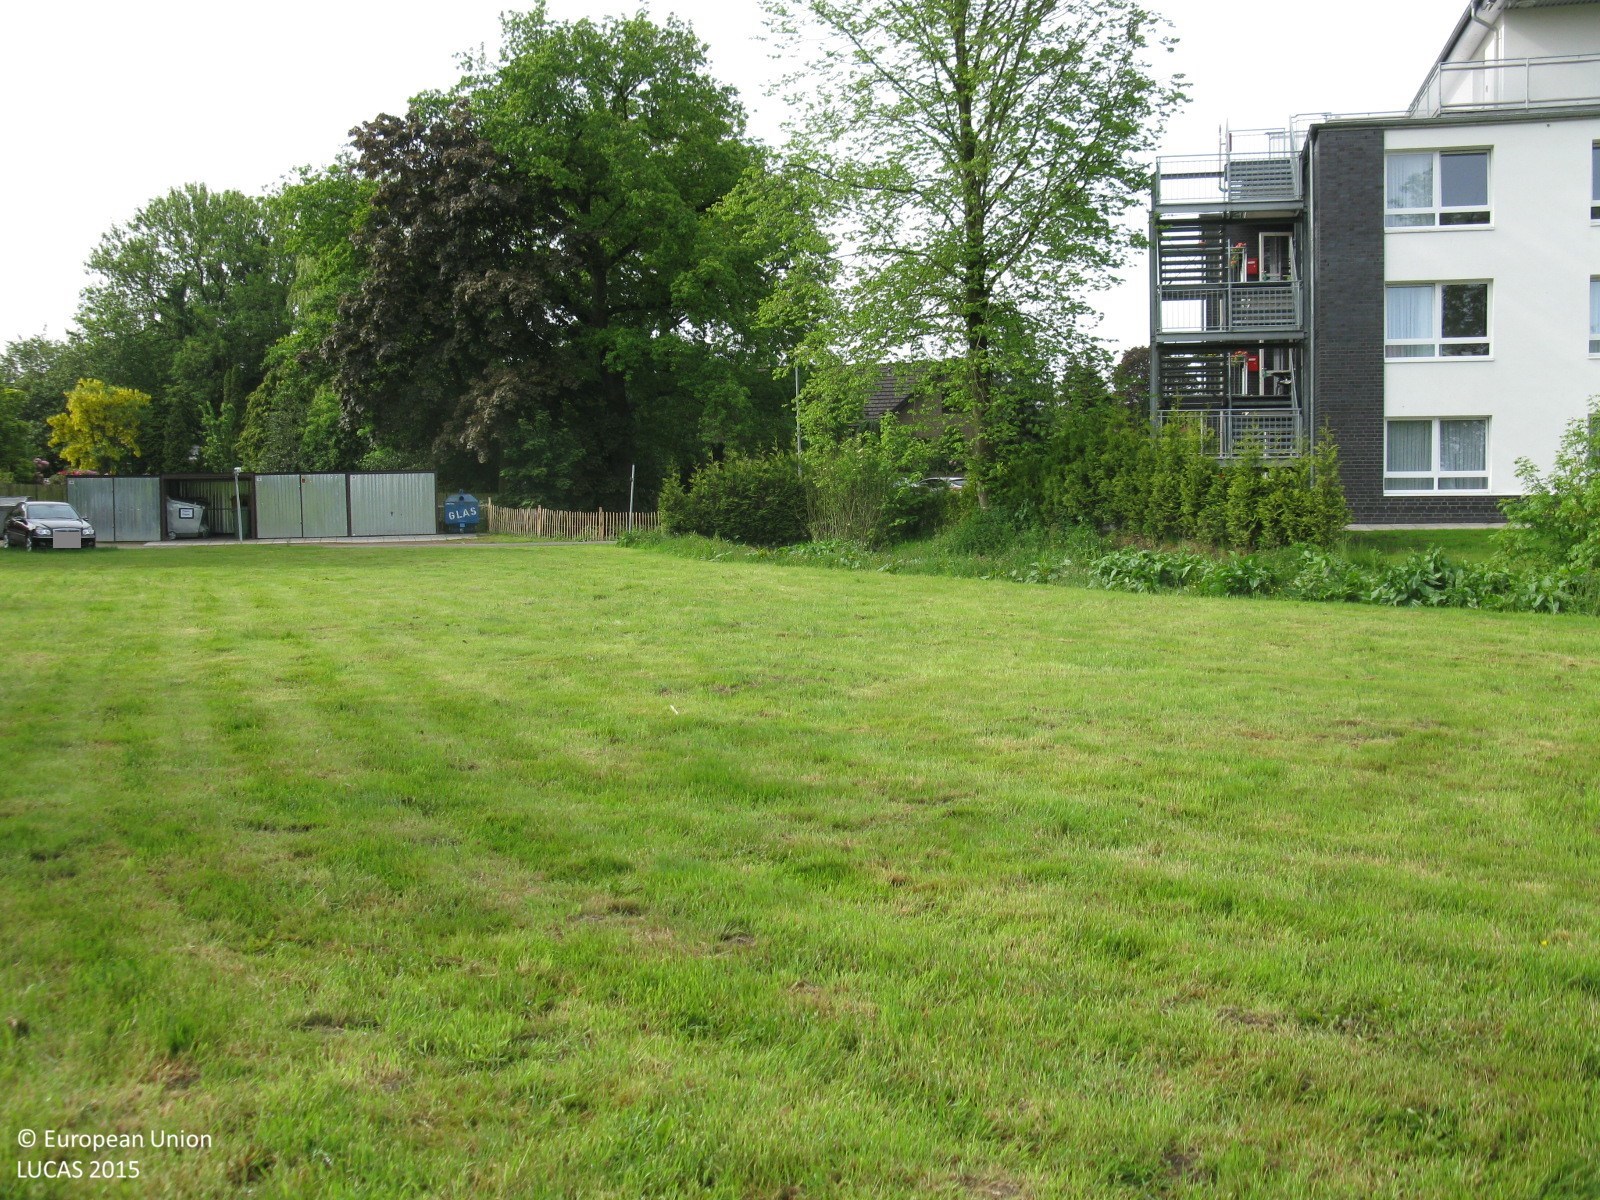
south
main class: Grassland
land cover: Grassland without tree/shrub cover
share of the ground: > 75 %
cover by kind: herbaceous plants 100 %
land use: Residential
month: June
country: DE
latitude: 53.0488
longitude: 7.3303
